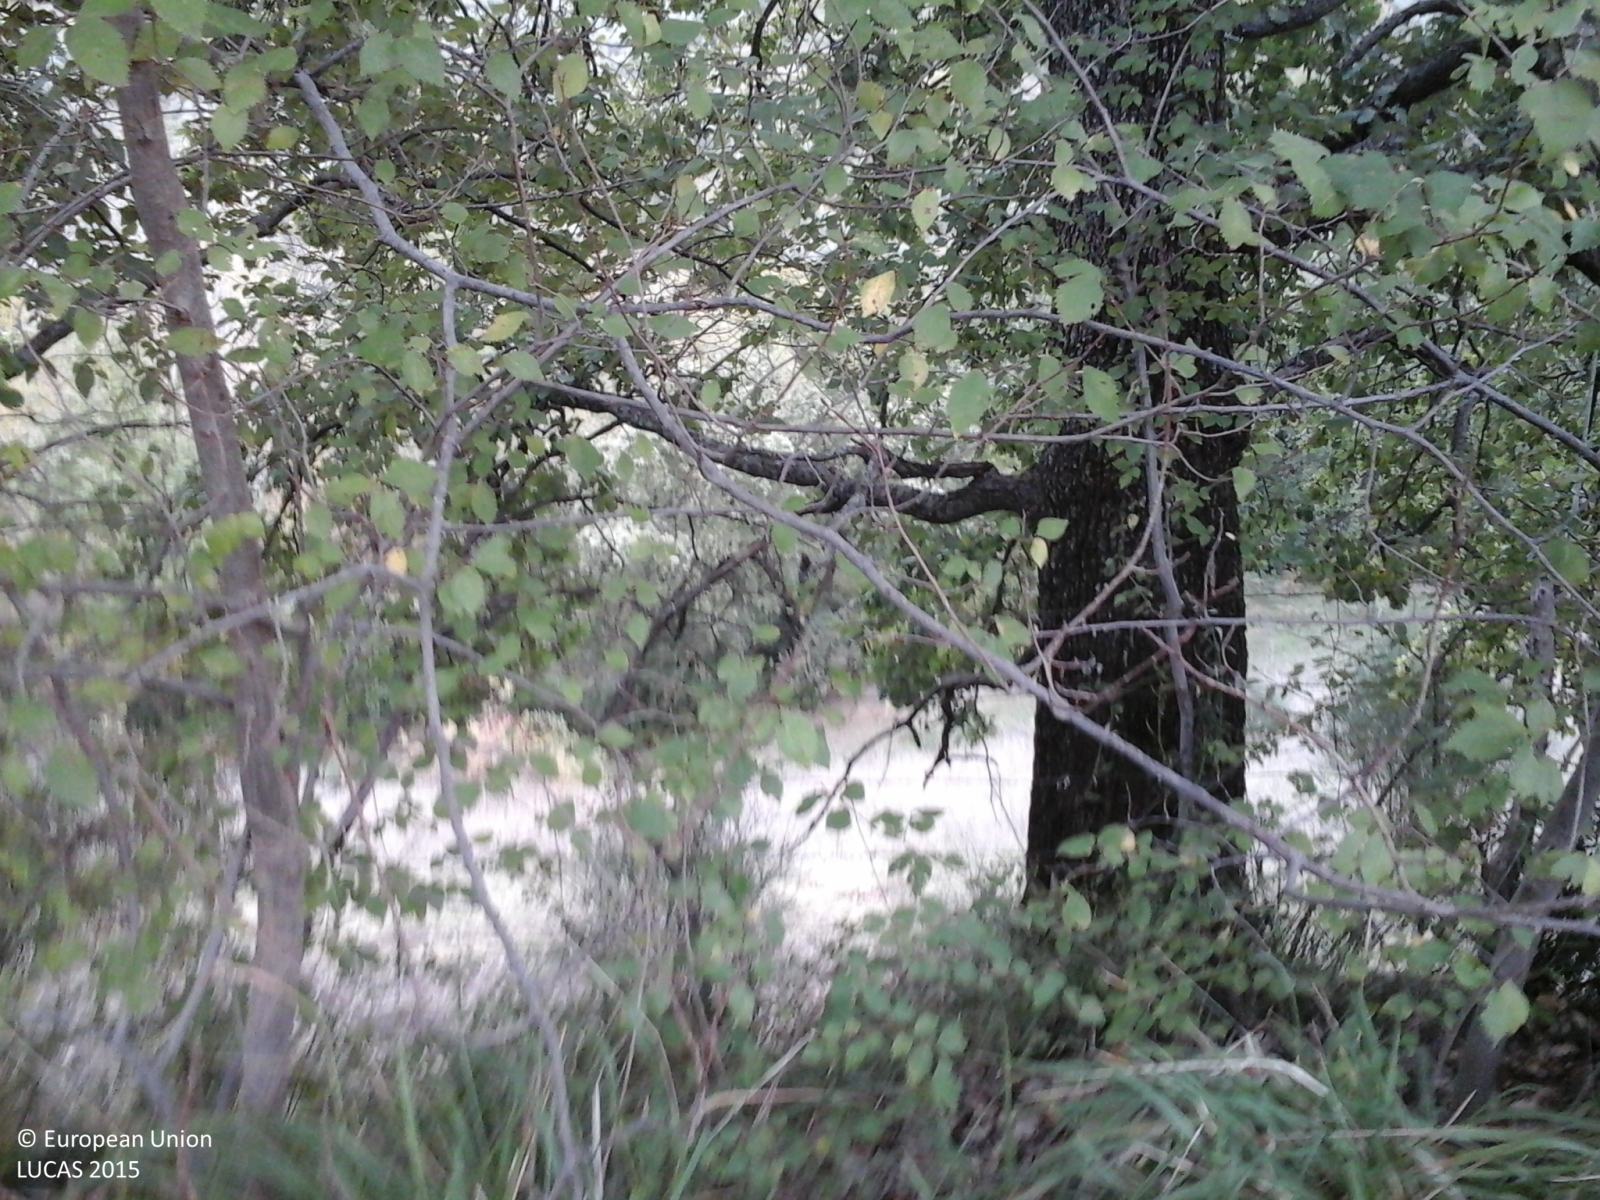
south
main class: Woodland
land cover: Broadleaved woodland
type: thermophilous deciduous forest
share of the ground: 50 - 75 %
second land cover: Grassland without tree/shrub cover
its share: 50 - 75 %
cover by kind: broadleaved forest trees 60 %, herbaceous plants 35 %, shrubs 5 %
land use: Forestry
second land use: Agriculture (excluding fallow land and kitchen gardens)
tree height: > 5 m
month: October
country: IT
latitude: 42.7647
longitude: 12.6192
